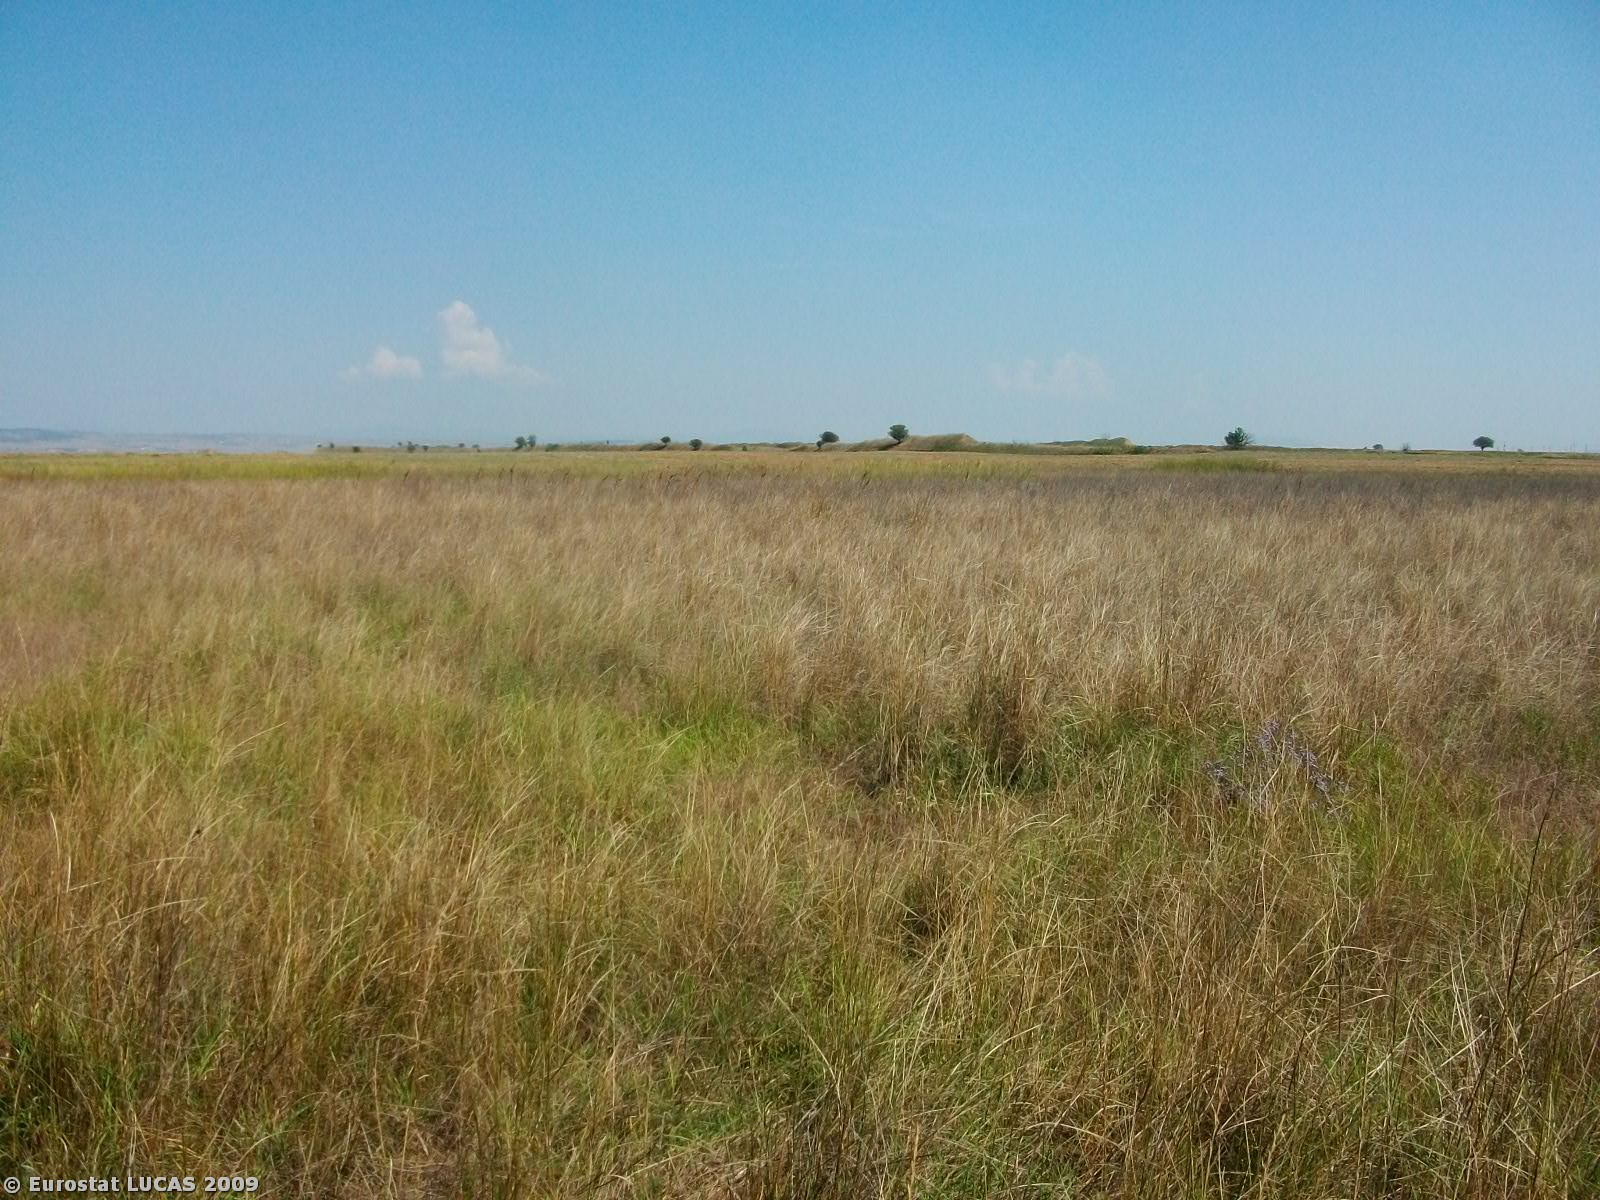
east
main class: Grassland
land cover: Grassland without tree/shrub cover
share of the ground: > 75 %
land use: Unused
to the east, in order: Grassland without tree/shrub cover; Barley; Grass margins; Paved roads, cycling and walking lanes; Grass margins; Bare land
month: September
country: GR
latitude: 40.8481
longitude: 22.6864
